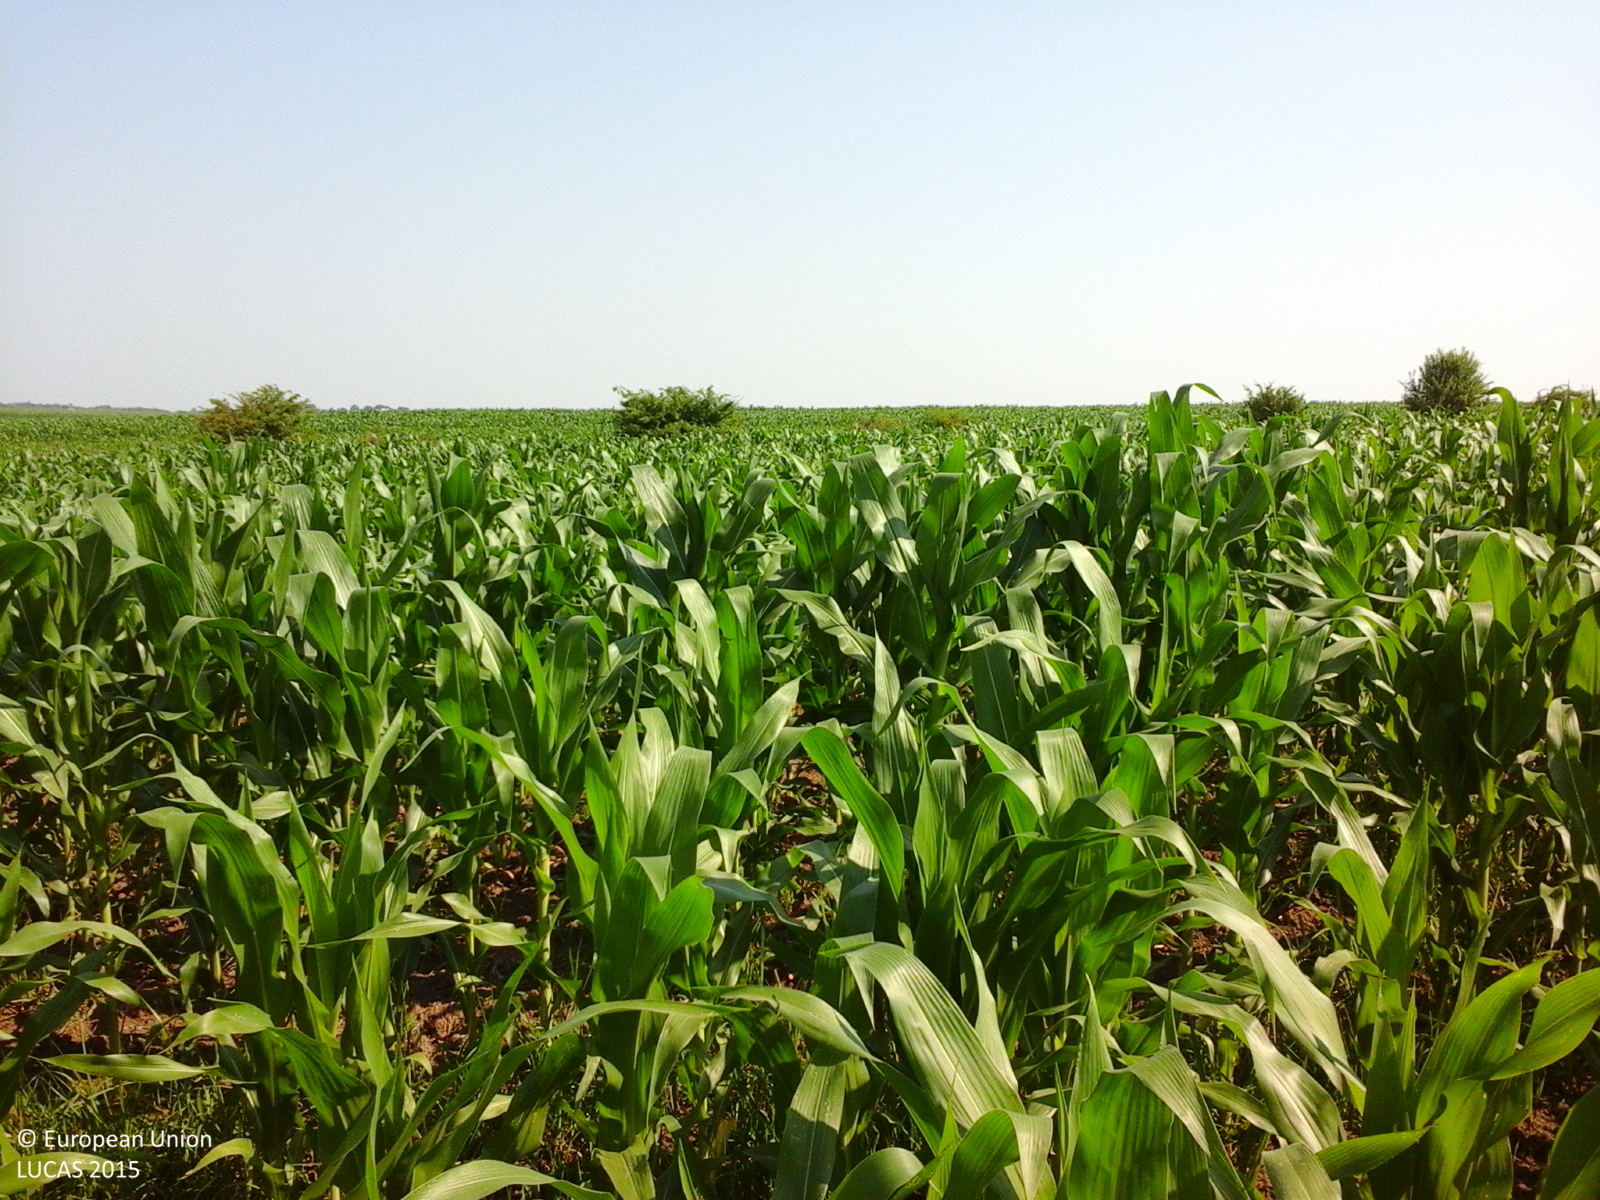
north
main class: Cropland
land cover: Maize
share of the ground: > 75 %
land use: Agriculture (excluding fallow land and kitchen gardens)
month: July
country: RO
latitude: 44.6493
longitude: 24.5873
